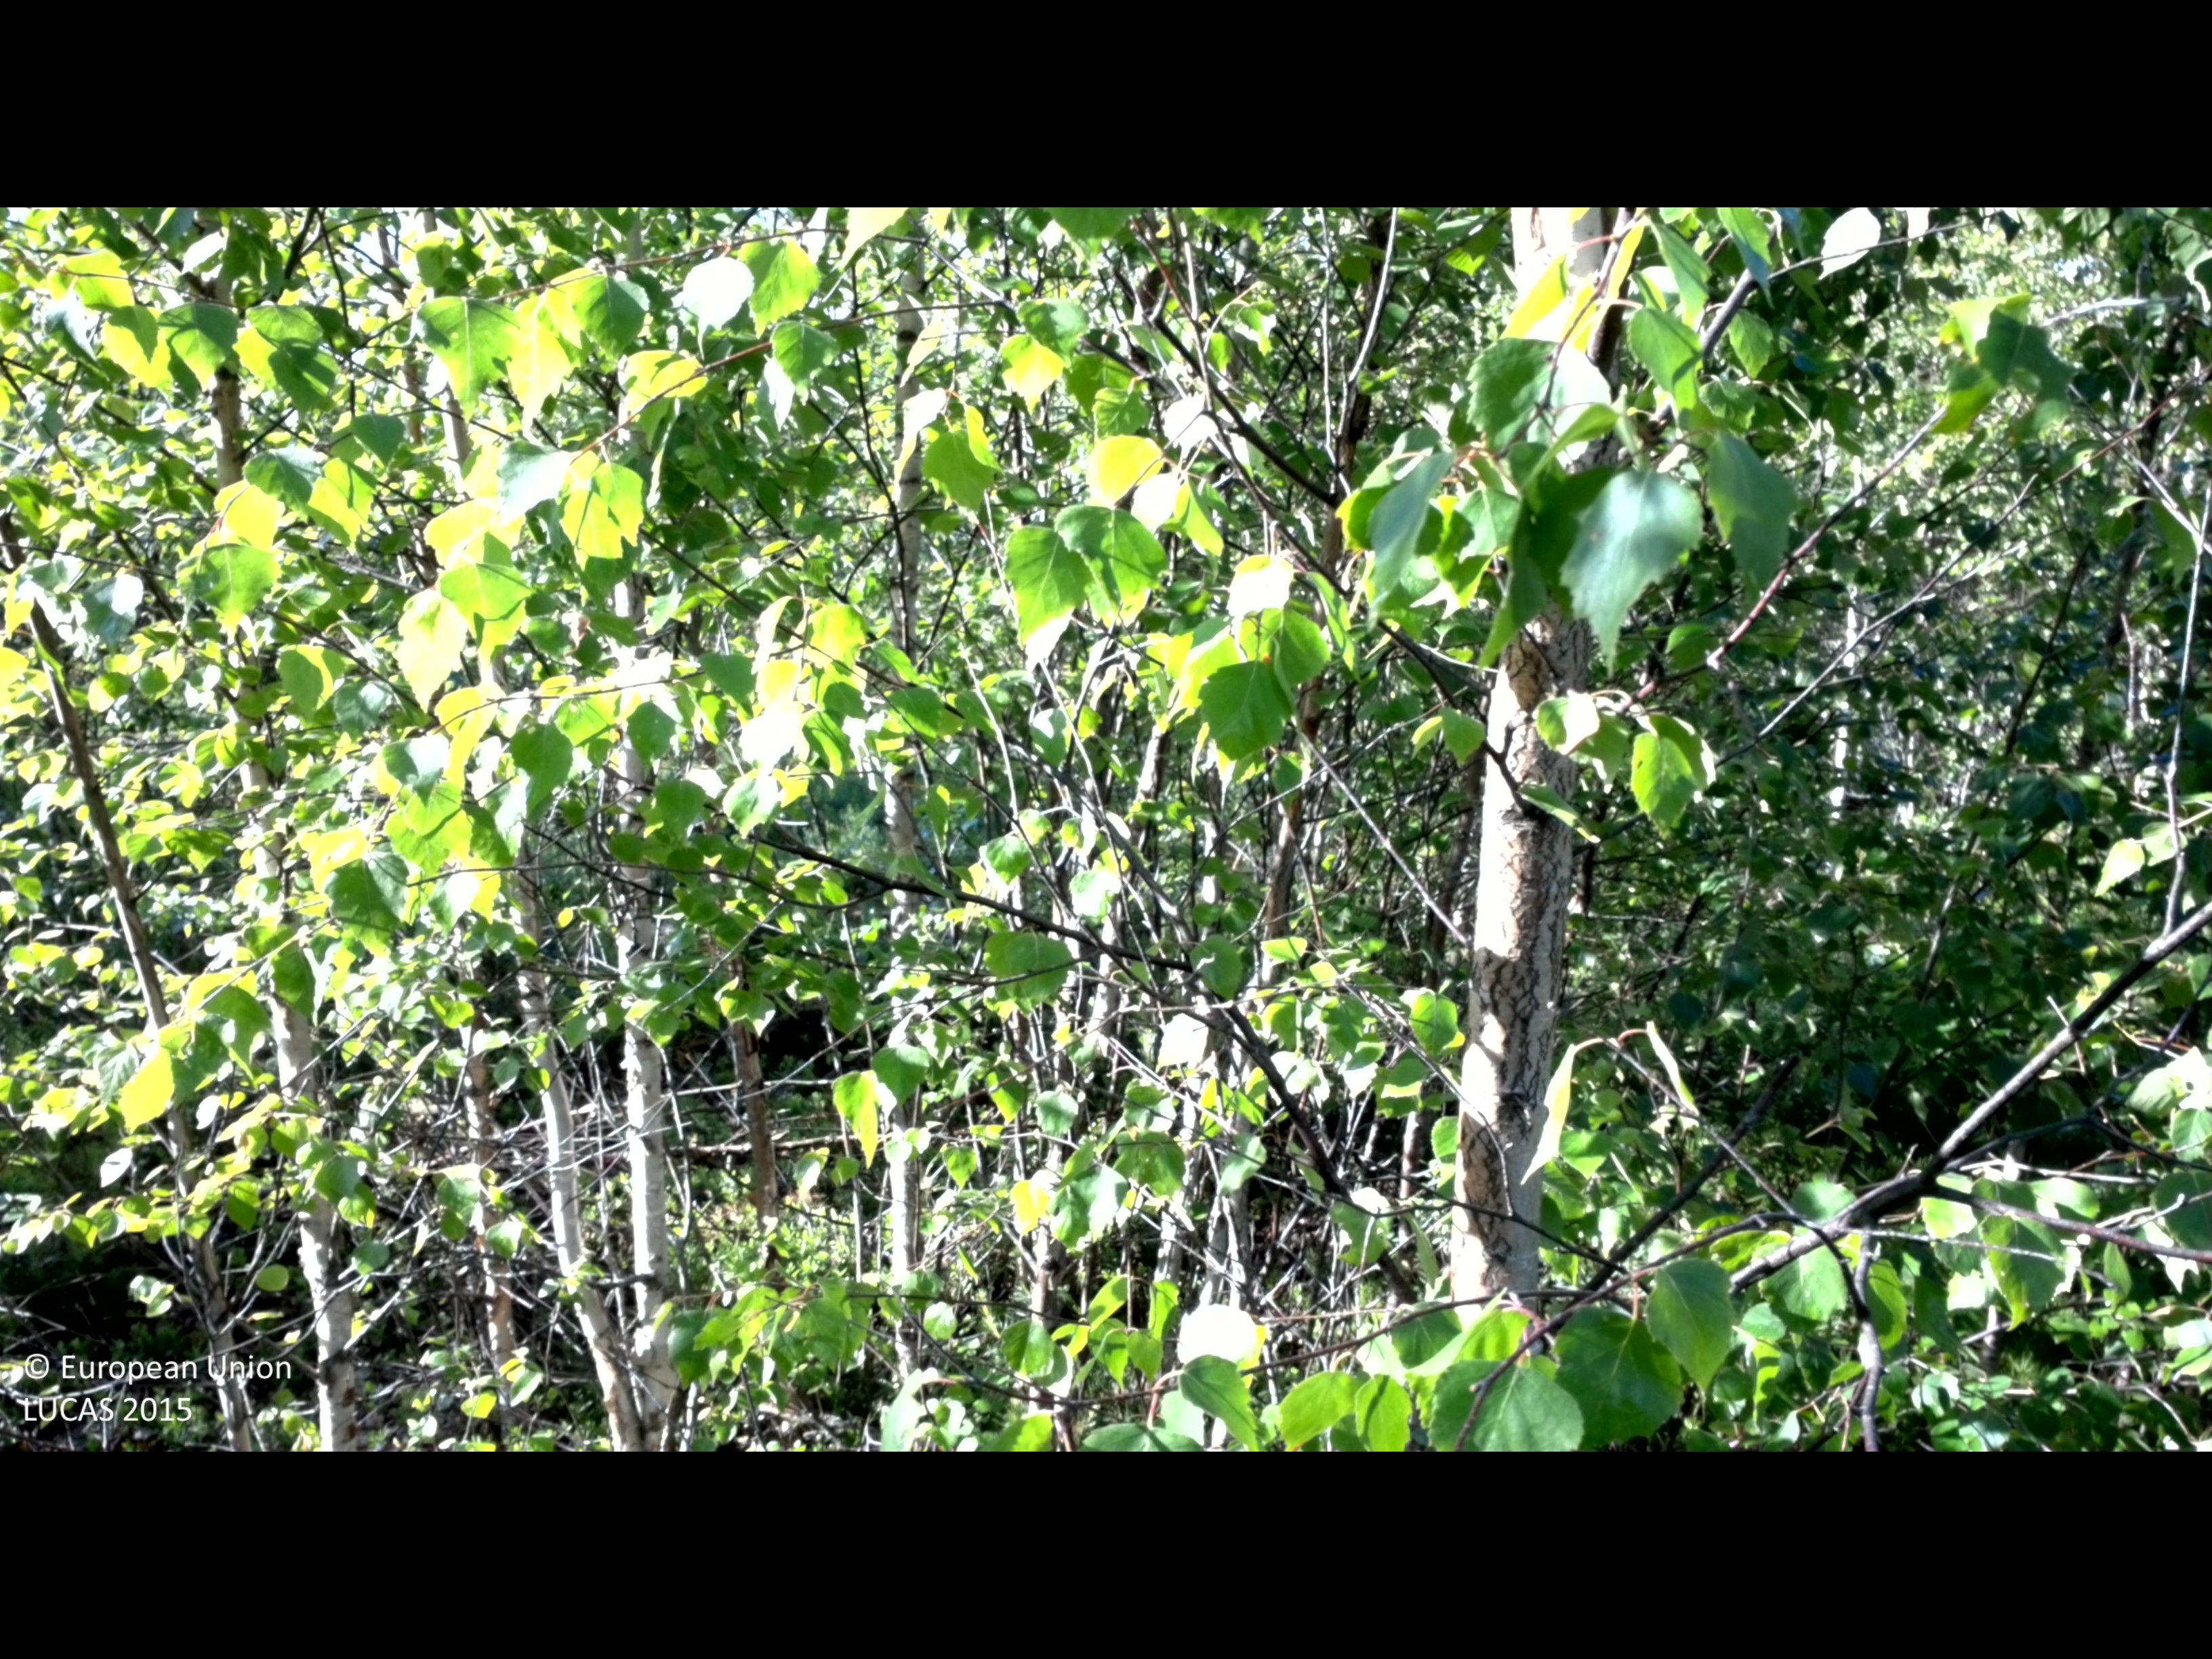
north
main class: Woodland
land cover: Broadleaved woodland
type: boreal forest
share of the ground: > 75 %
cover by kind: broadleaved forest trees 75 %, shrubs 25 %
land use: Forestry
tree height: < 5 m
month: June
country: SE
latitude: 58.1534
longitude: 16.0964
